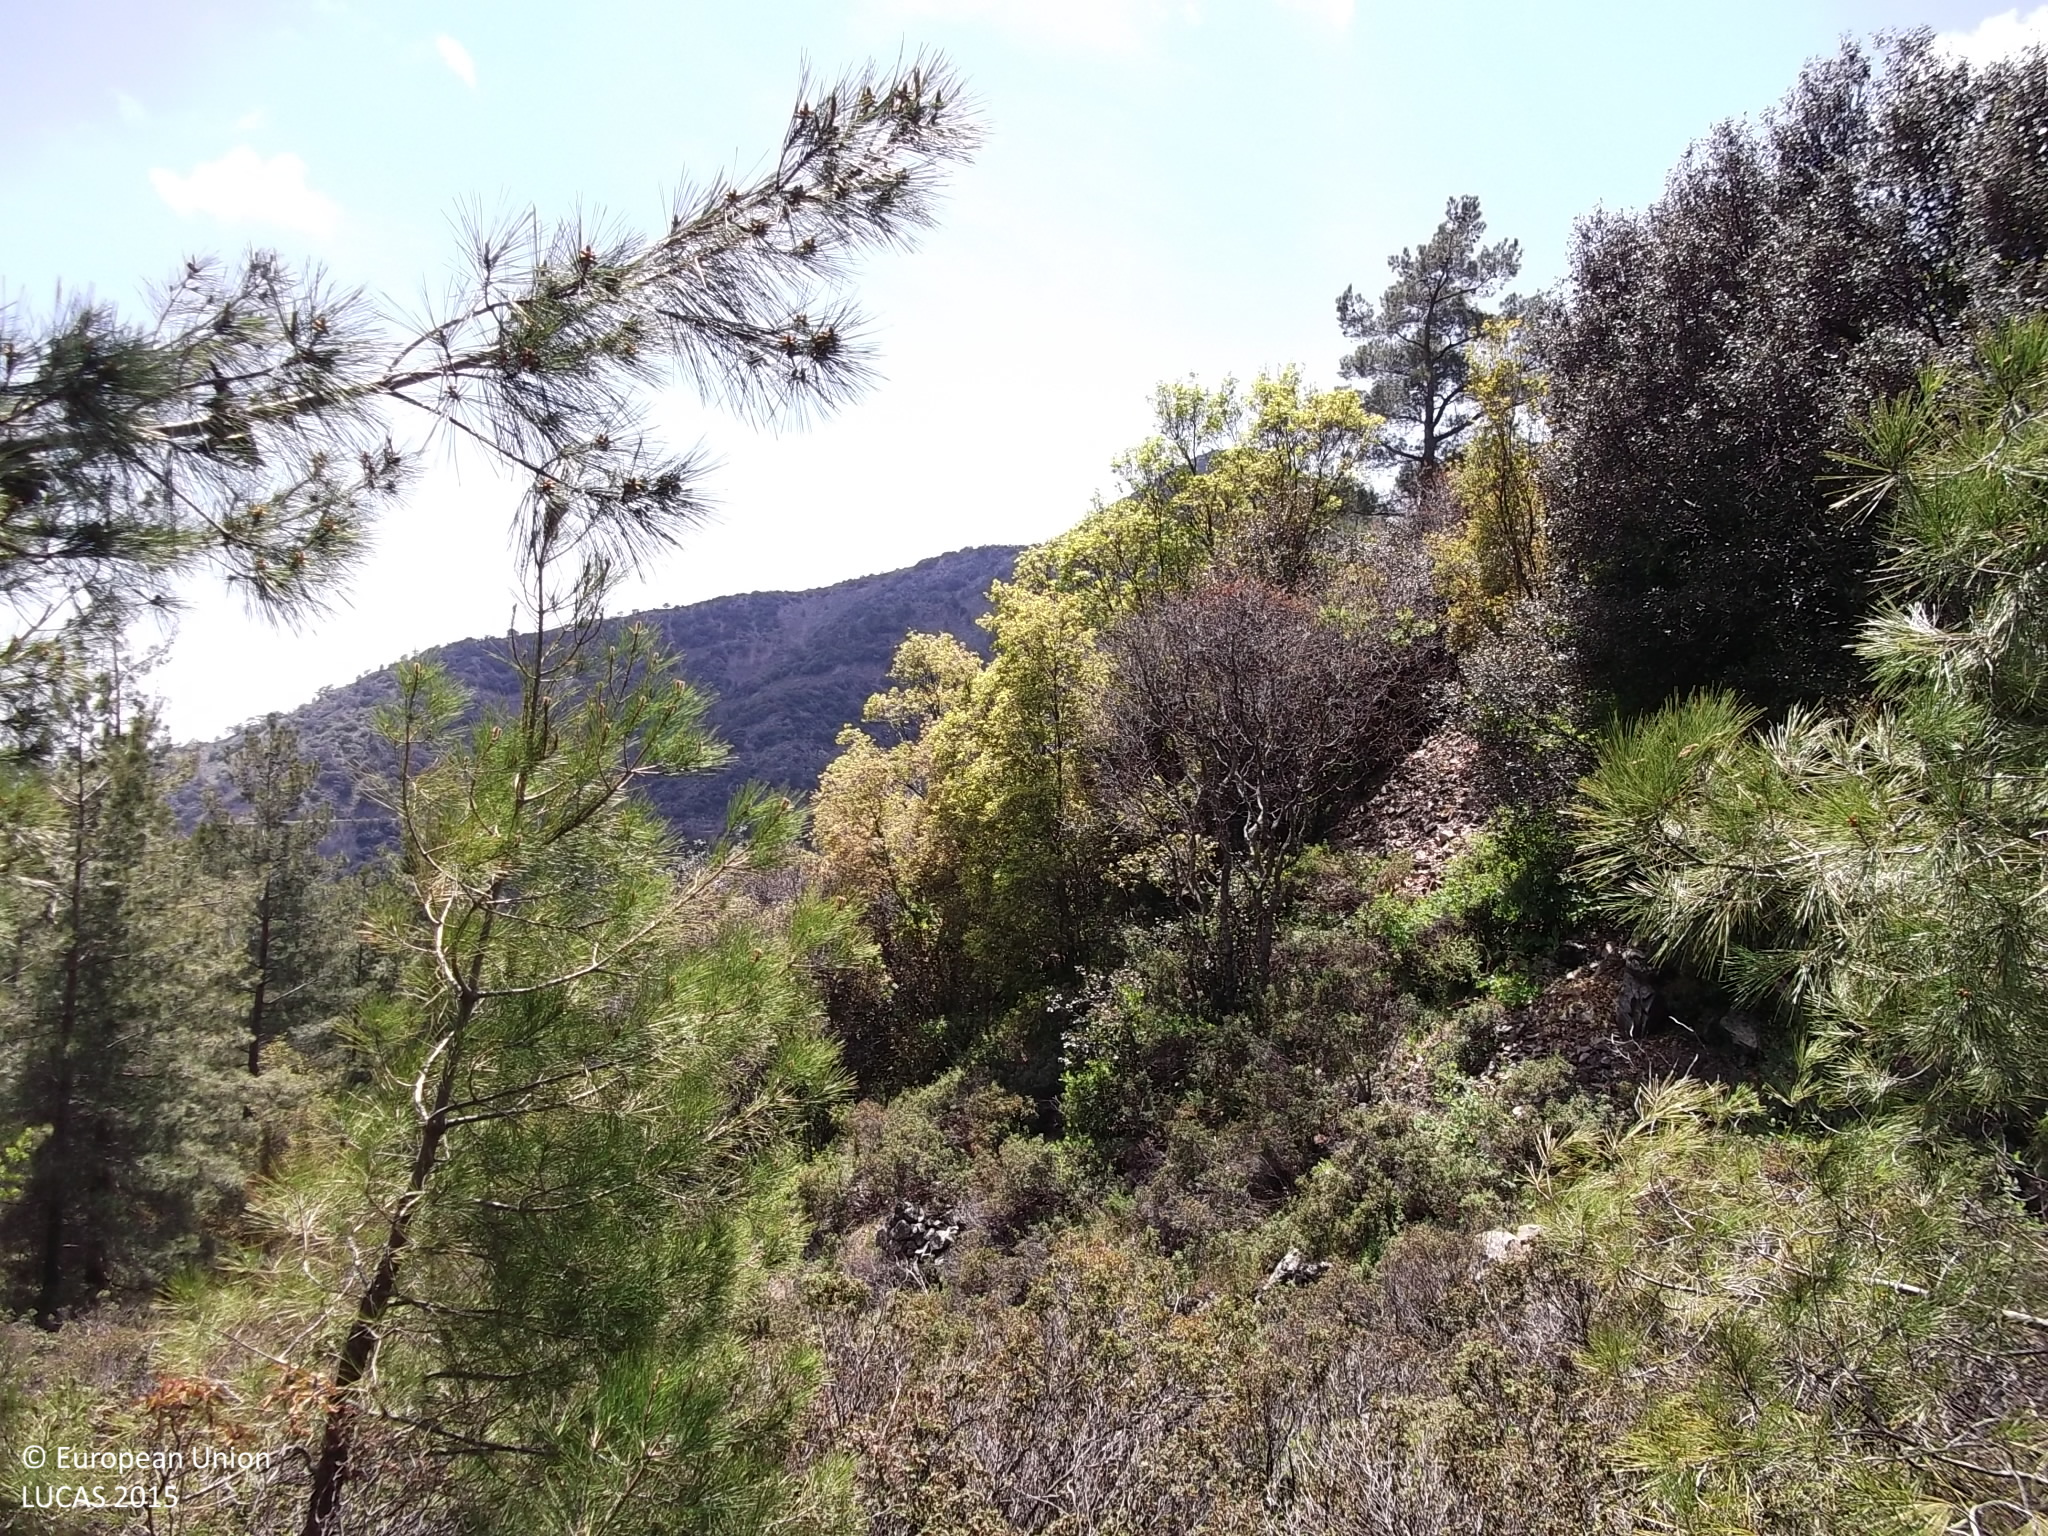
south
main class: Woodland
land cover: Pine dominated mixed woodland
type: coniferous forest of the mediterranean region
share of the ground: 25 - 50 %
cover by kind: shrubs 40 %, coniferous forest trees 35 %, broadleaved forest trees 15 %, consolidated bare surface 5 %, unconsolidated bare surface 5 %
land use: Semi-natural and natural areas not in use
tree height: > 5 m
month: April
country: CY
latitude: 34.9124
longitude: 33.1962
